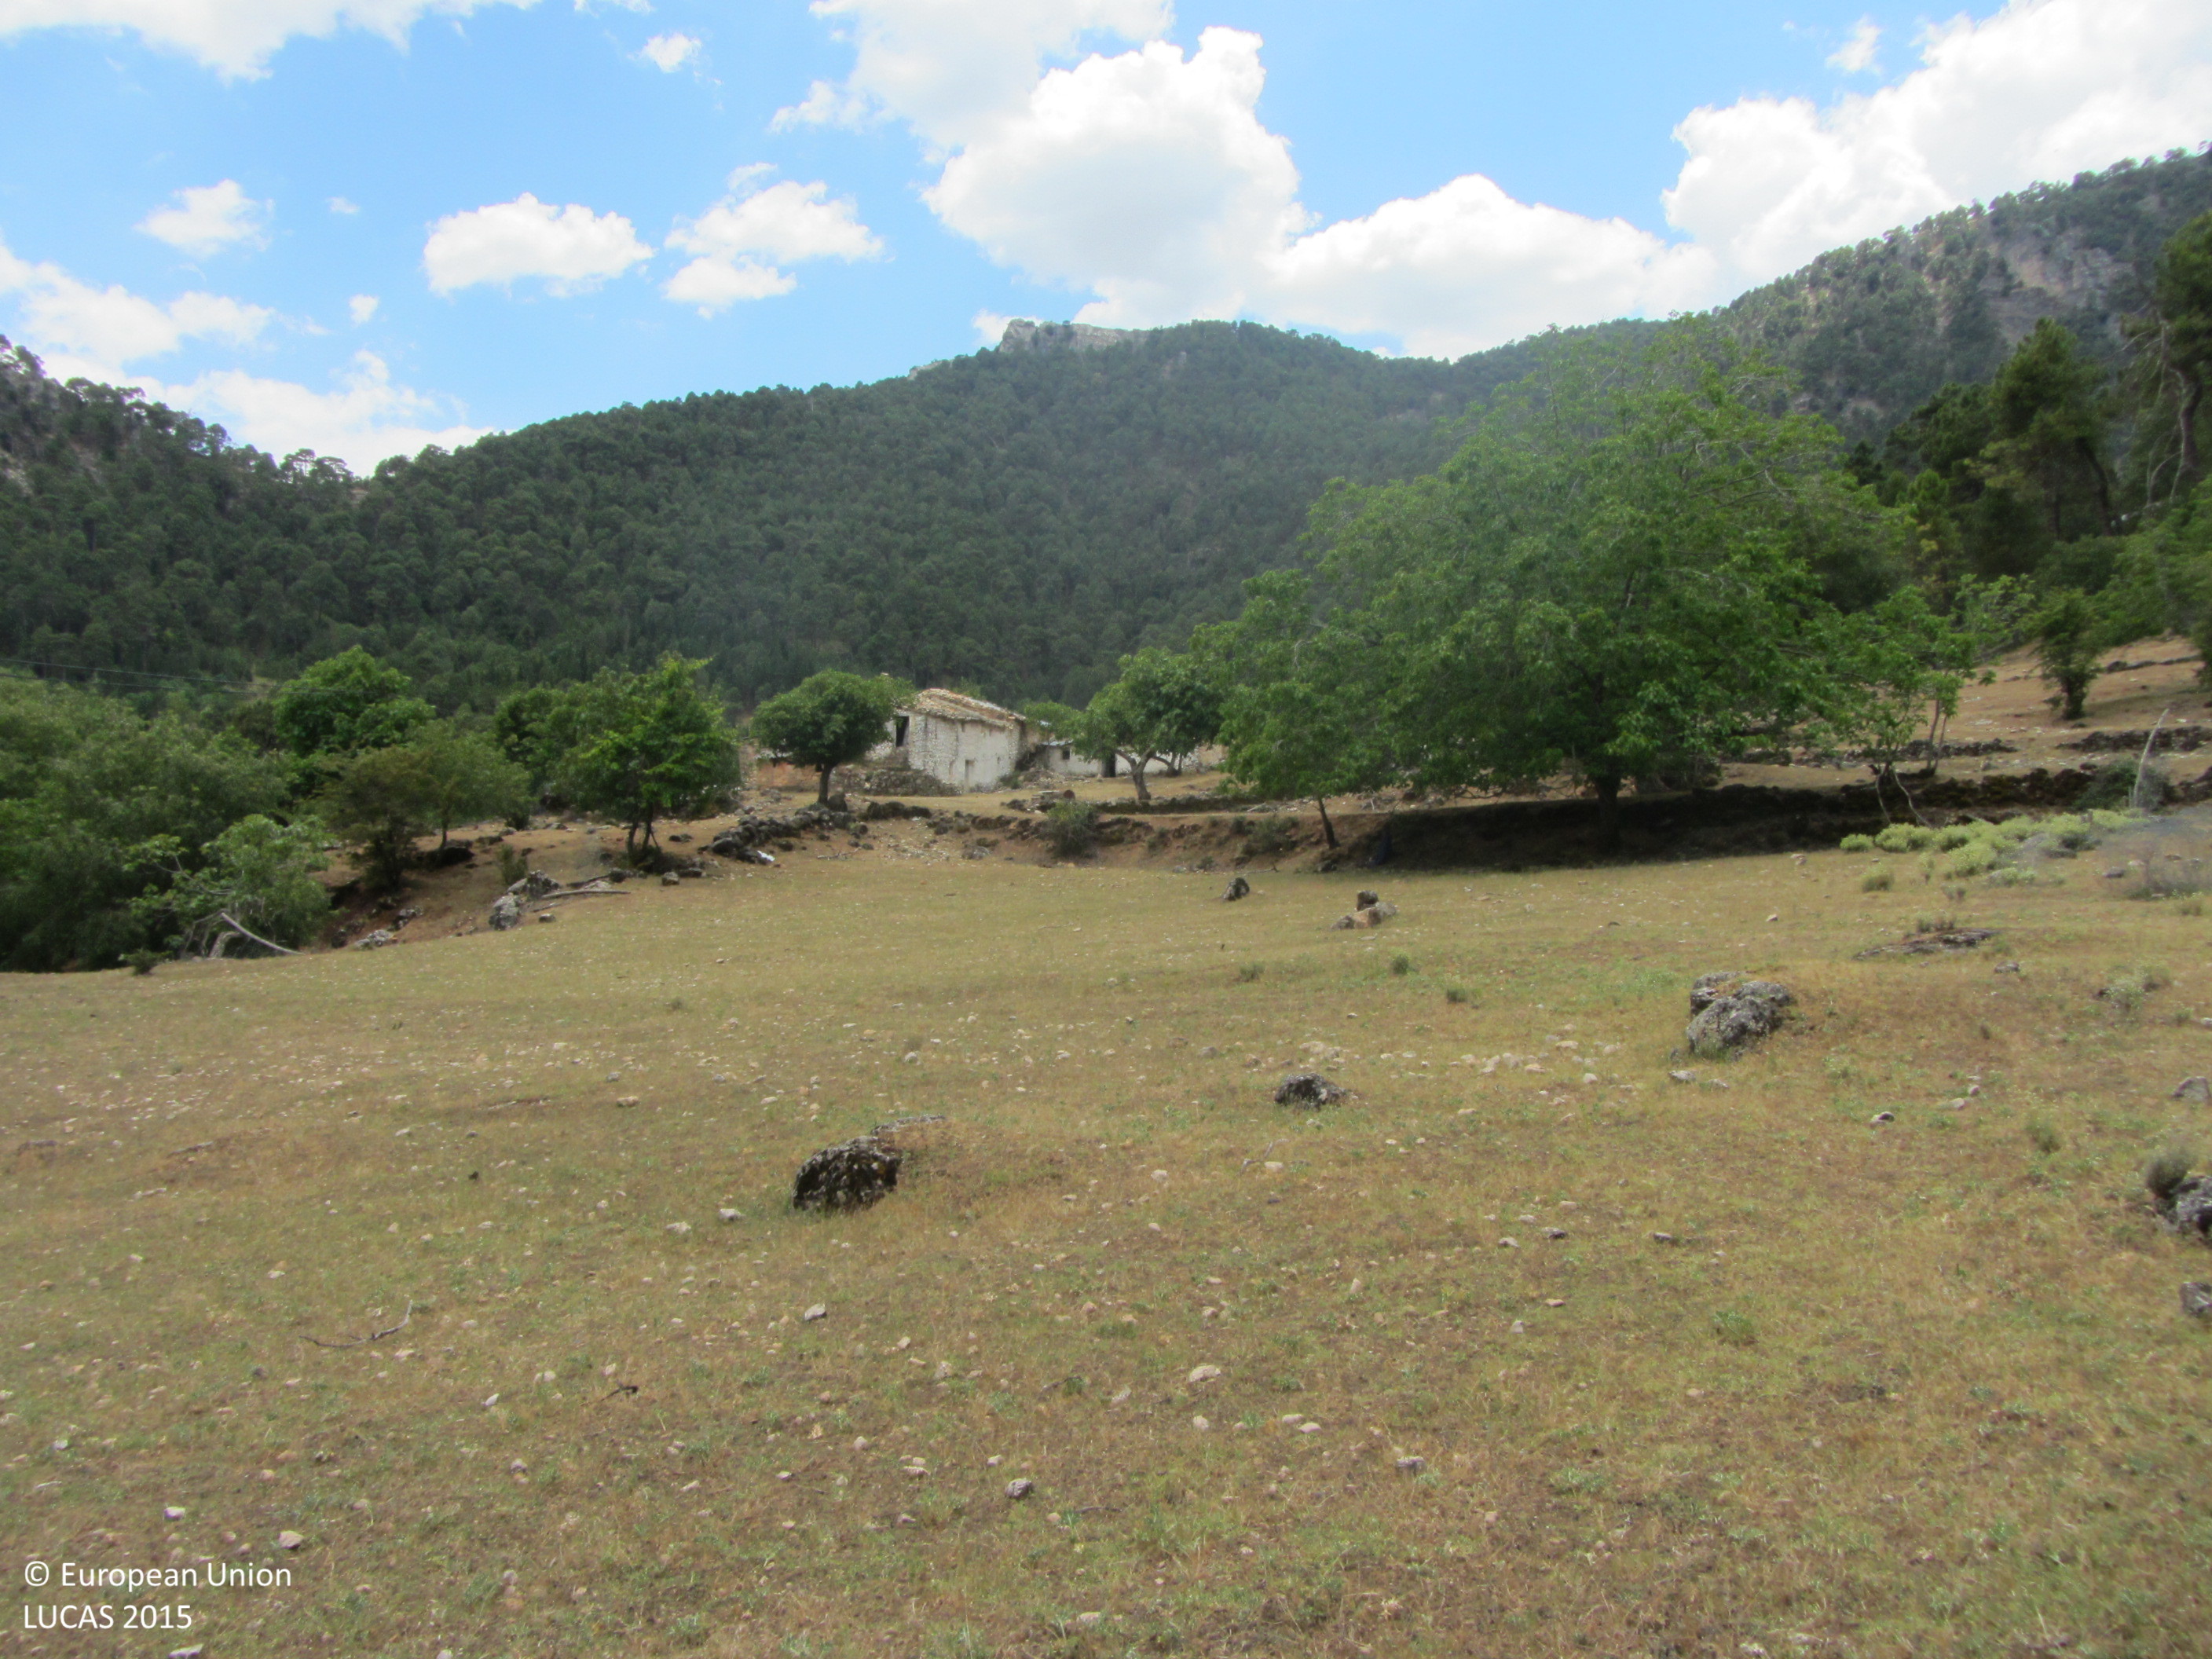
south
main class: Woodland
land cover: Pine dominated mixed woodland
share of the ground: > 75 %
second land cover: Grassland without tree/shrub cover
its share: > 75 %
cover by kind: herbaceous plants 60 %, broadleaved forest trees 20 %, coniferous forest trees 10 %, consolidated bare surface 10 %
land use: Forestry
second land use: Agriculture (excluding fallow land and kitchen gardens)
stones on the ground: < 10 %
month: June
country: ES
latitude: 37.9213
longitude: -2.9519
